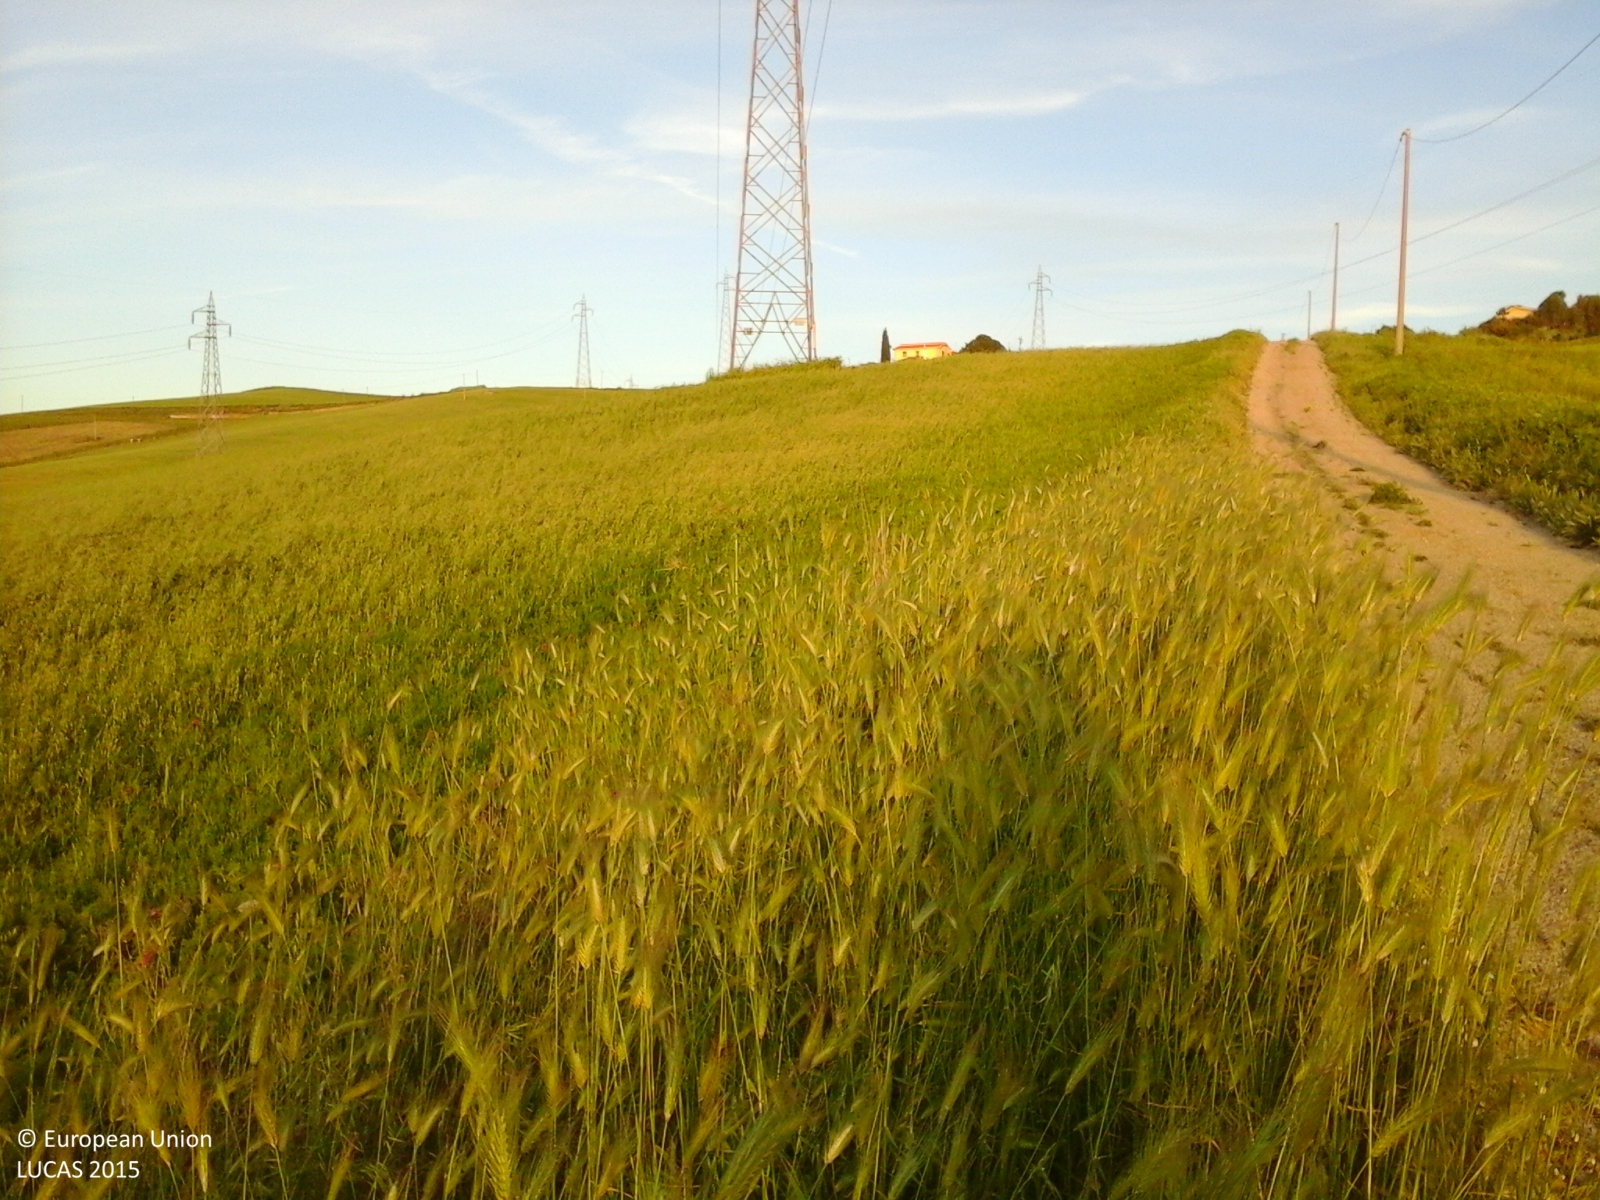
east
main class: Cropland
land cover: Other leguminous and mixtures for fodder
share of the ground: > 75 %
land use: Agriculture (excluding fallow land and kitchen gardens)
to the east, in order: Other leguminous and mixtures for fodder; Grass margins; Other leguminous and mixtures for fodder; Grassland with sparse tree/shrub cover; Other leguminous and mixtures for fodder; Rocks and stones; Other leguminous and mixtures for fodder; Grassland without tree/shrub cover; Durum wheat
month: May
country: IT
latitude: 37.5348
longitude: 14.0327
